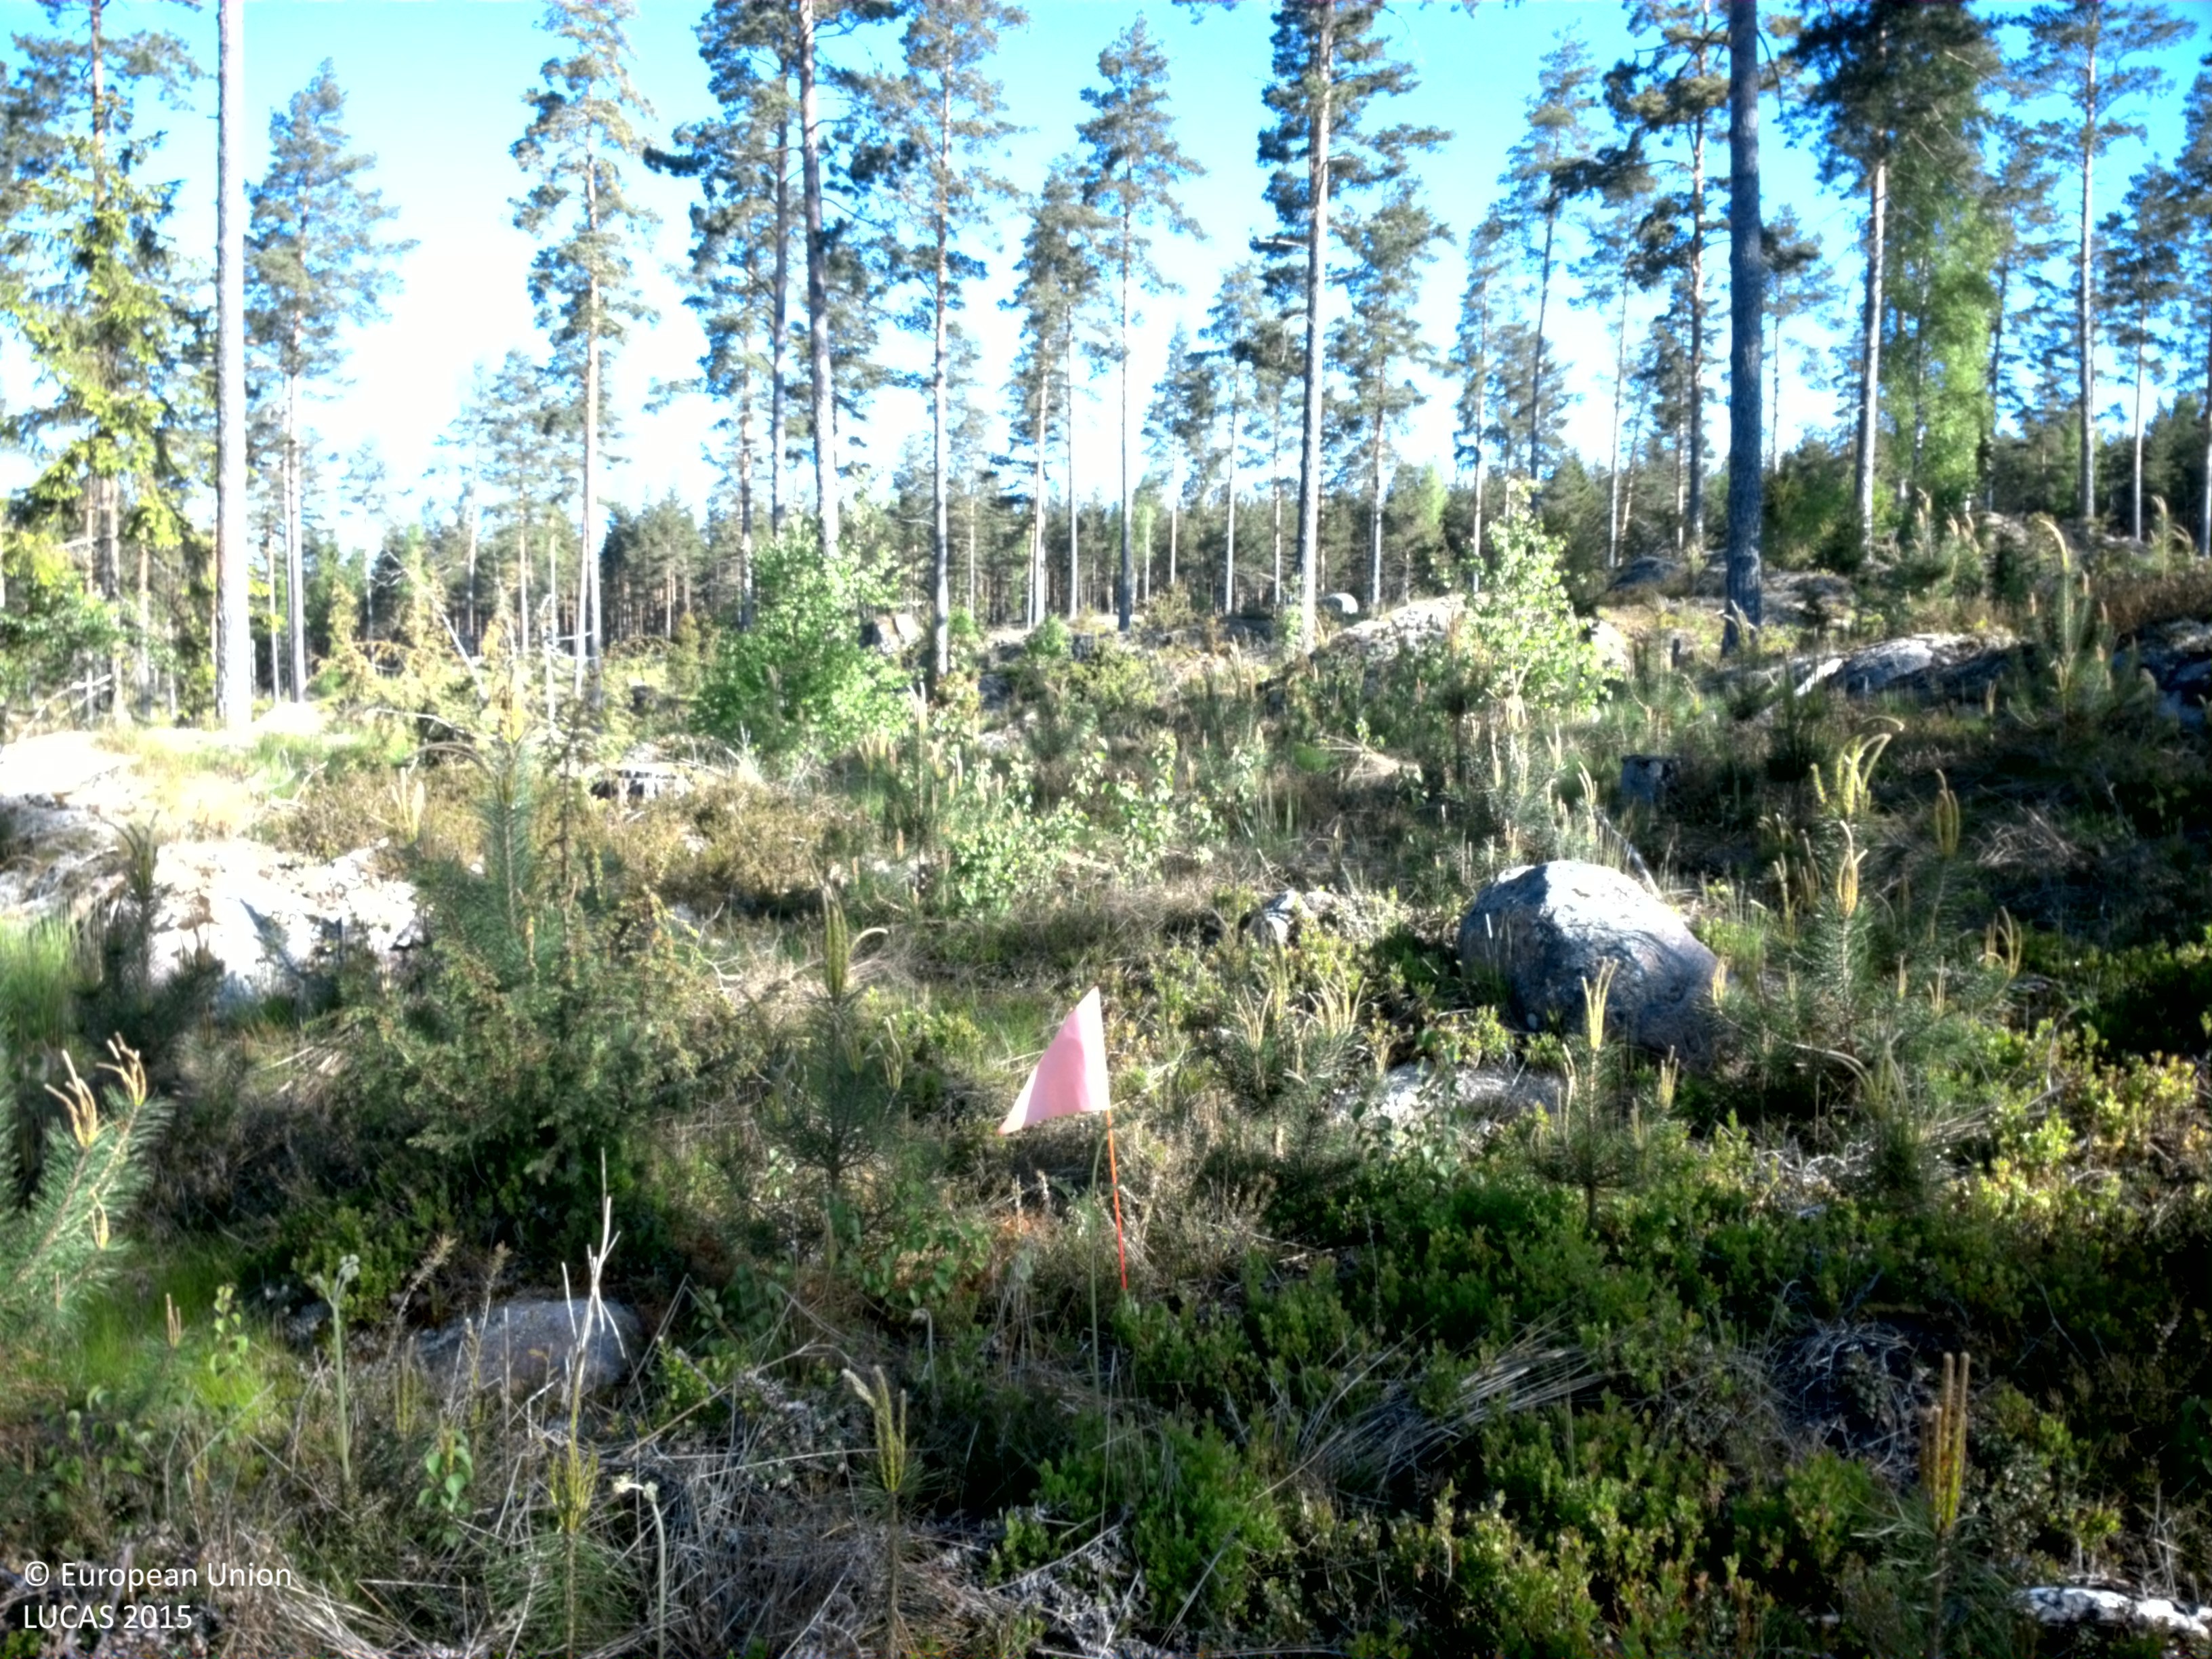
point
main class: Woodland
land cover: Pine dominated coniferous woodland
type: boreal forest
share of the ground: 25 - 50 %
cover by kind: shrubs 40 %, coniferous forest trees 30 %, broadleaved forest trees 10 %, herbaceous plants 10 %, lichens and mosses 10 %
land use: Forestry
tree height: > 5 m
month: May
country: SE
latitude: 57.4058
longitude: 15.8732
